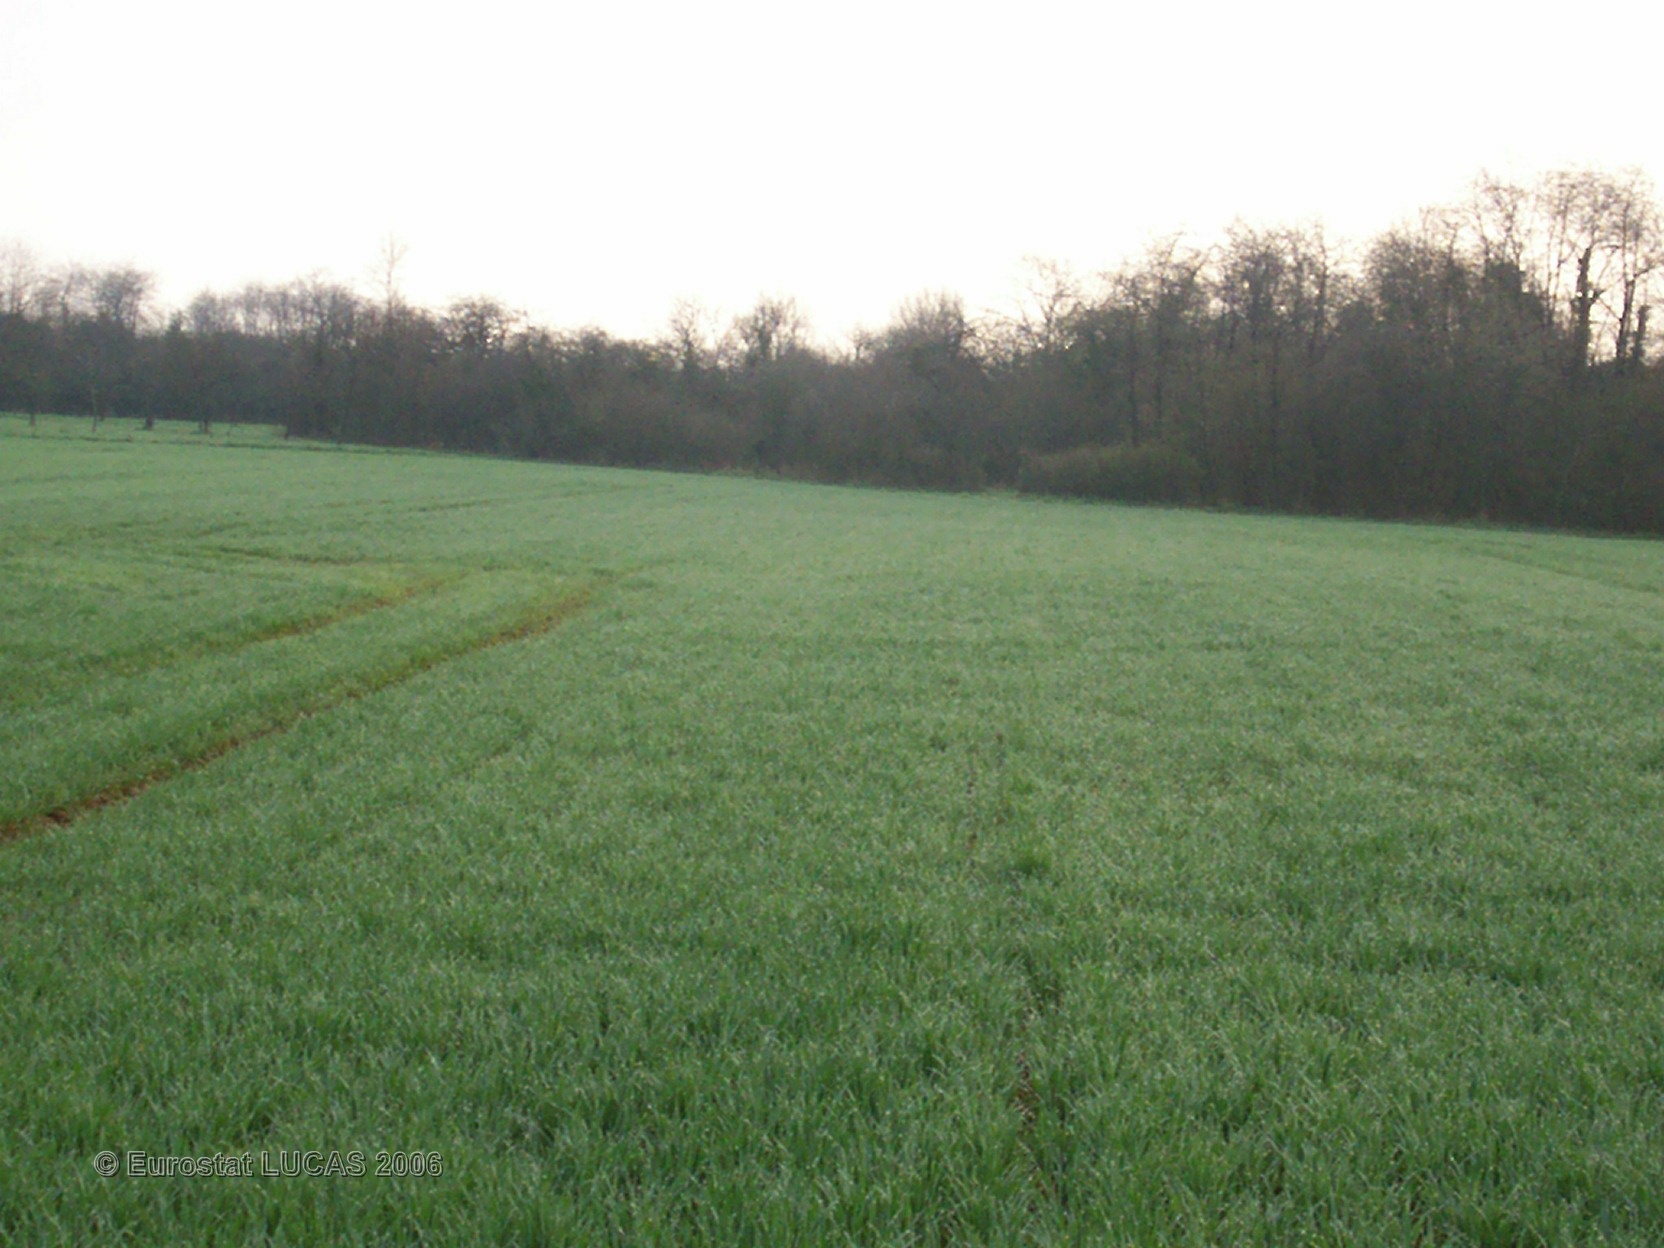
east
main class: Cropland
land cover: Common wheat
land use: Agriculture (excluding fallow land and kitchen gardens)
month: April
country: FR
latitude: 48.6543
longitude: 5.9680
